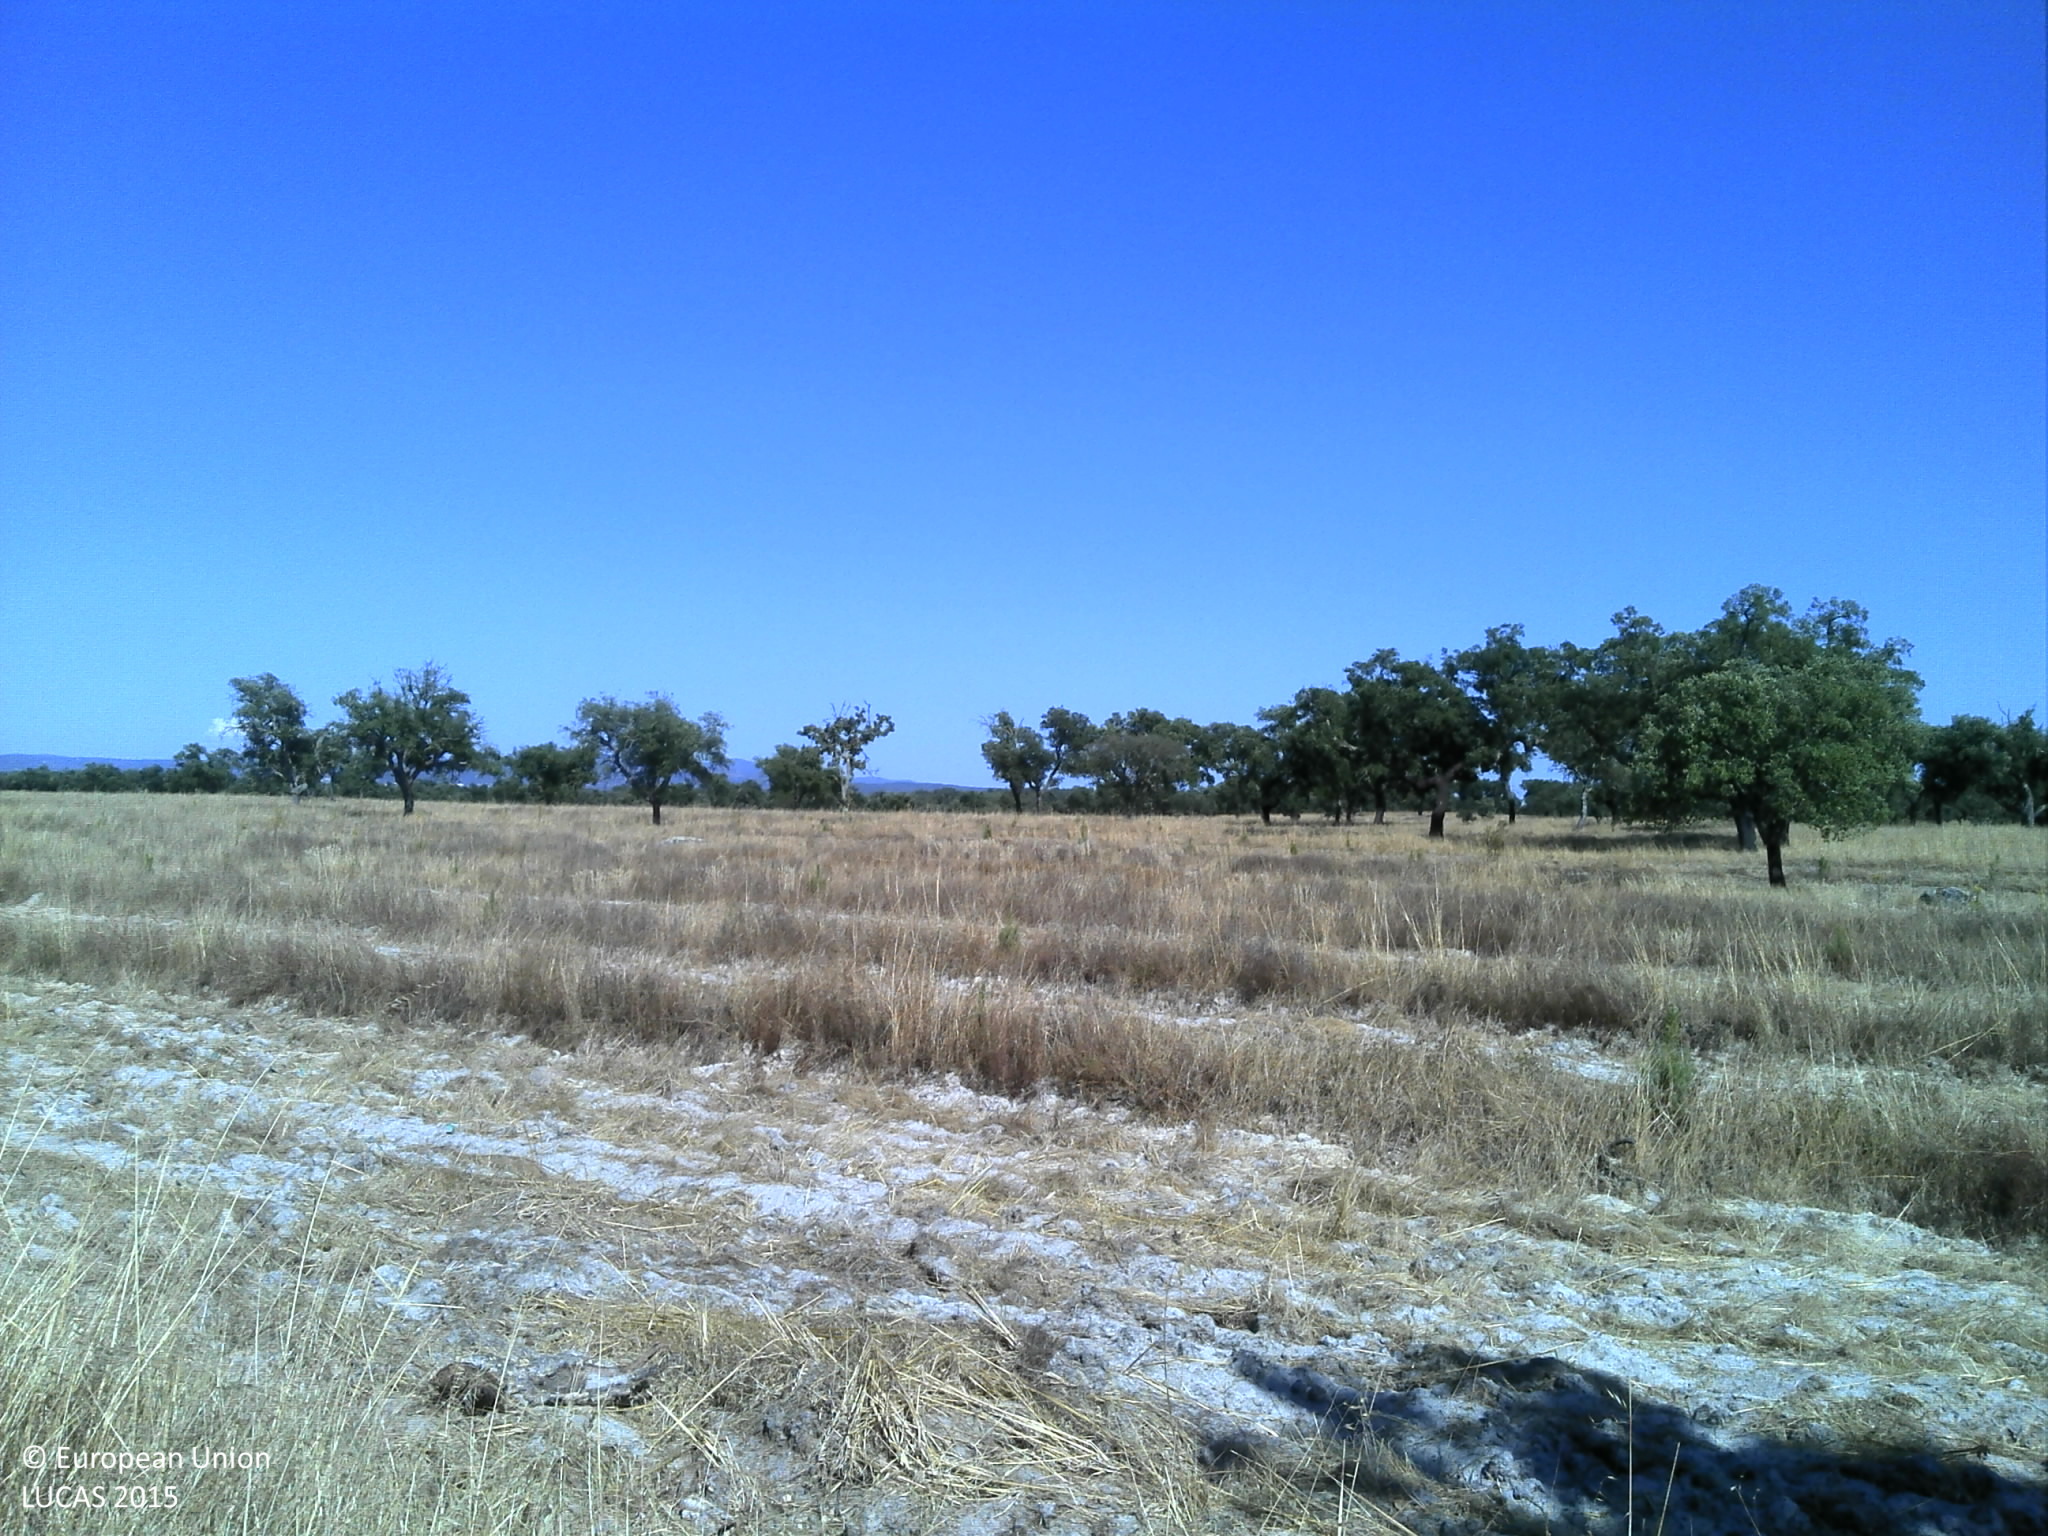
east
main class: Grassland
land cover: Grassland with sparse tree/shrub cover
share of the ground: 10 - 25 %
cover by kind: unconsolidated bare surface 80 %, herbaceous plants 15 %, broadleaved forest trees 5 %
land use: Forestry
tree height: < 5 m
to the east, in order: Grassland with sparse tree/shrub cover; Broadleaved woodland; Tracks; Grassland with sparse tree/shrub cover; Broadleaved woodland; Grassland with sparse tree/shrub cover
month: July
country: PT
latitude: 39.3190
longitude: -7.6426
